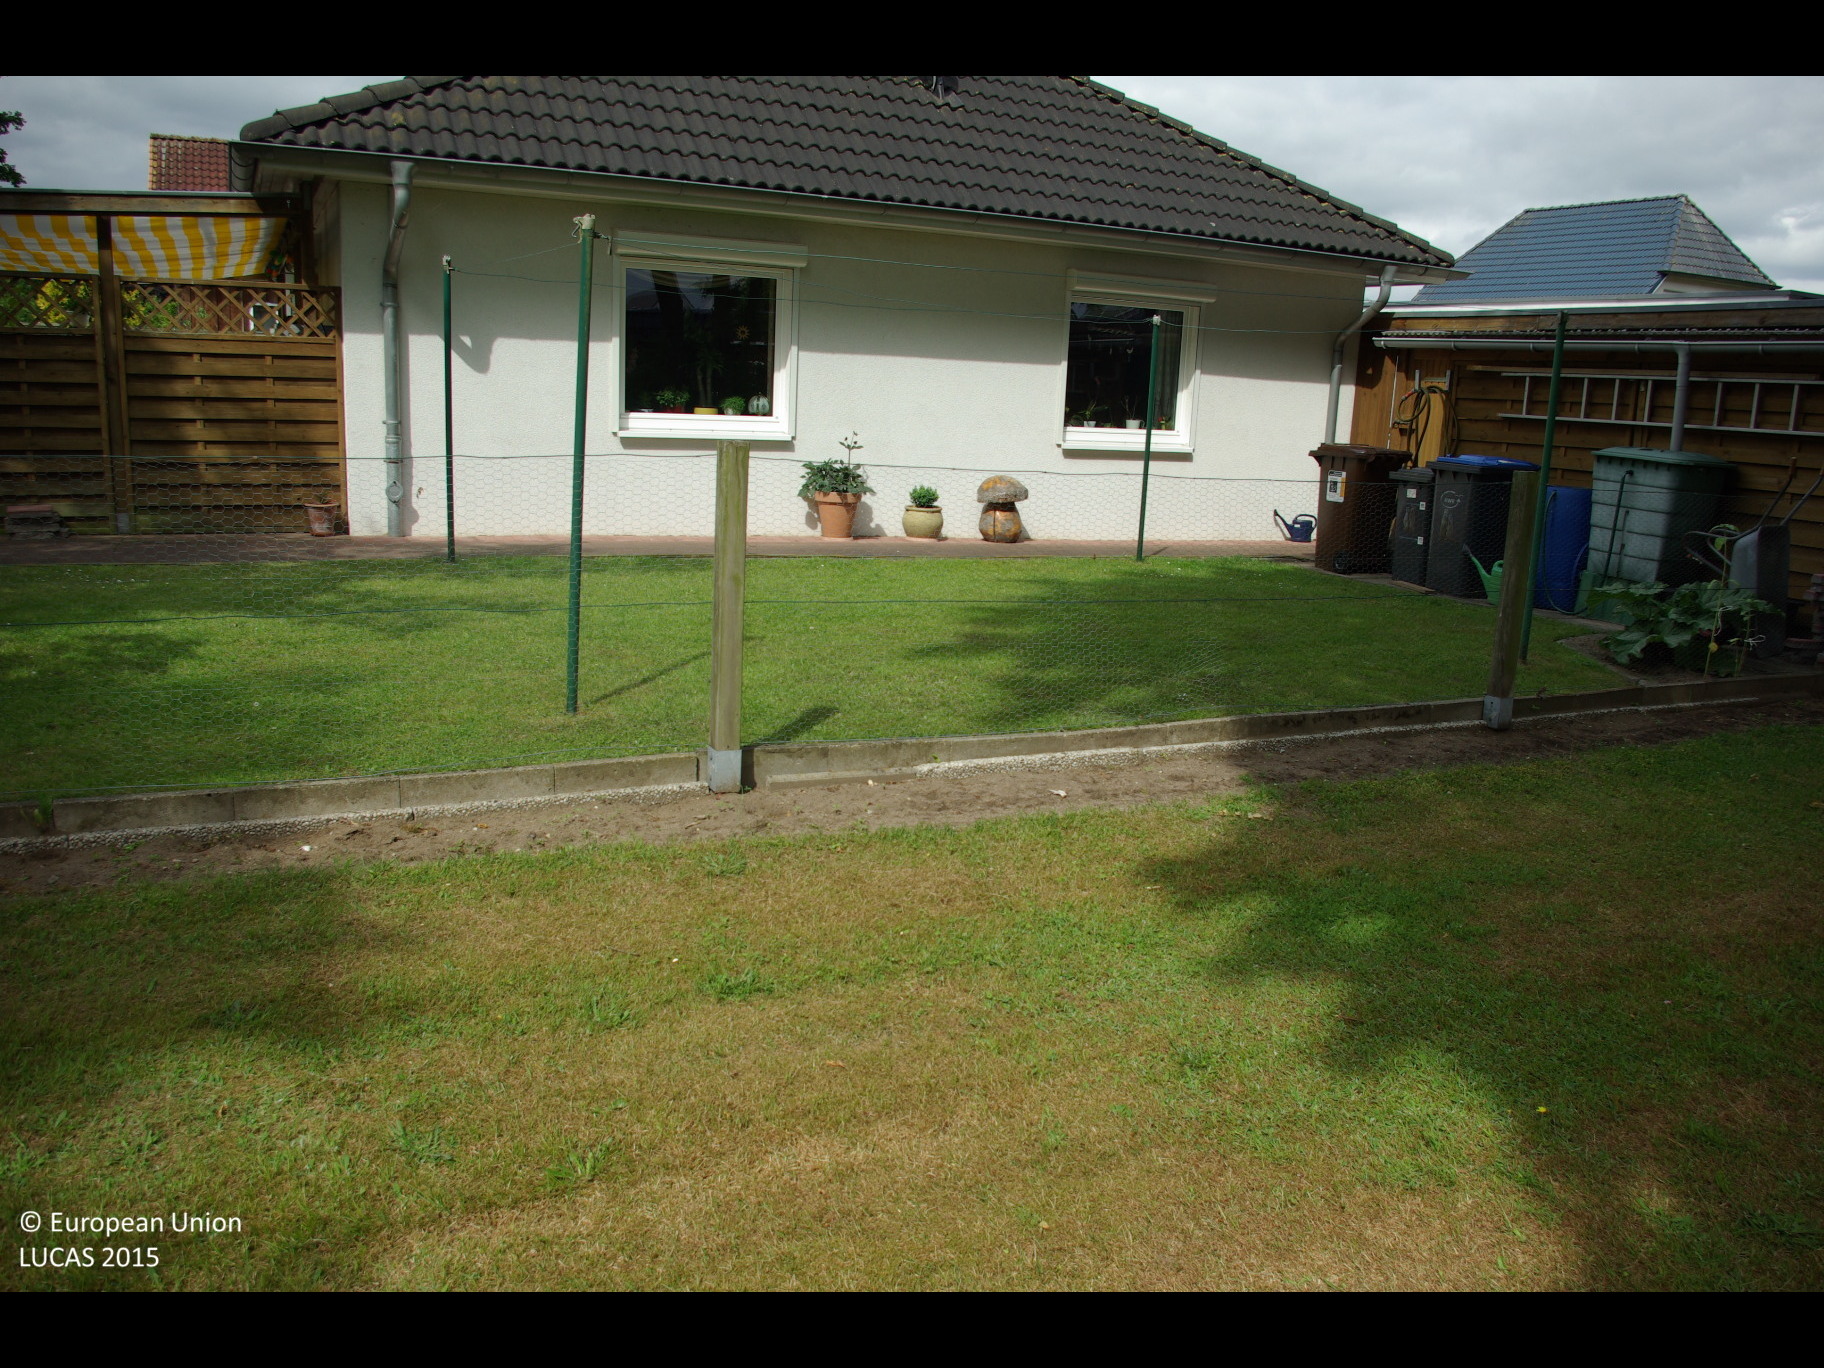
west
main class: Grassland
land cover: Grassland without tree/shrub cover
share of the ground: > 75 %
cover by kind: herbaceous plants 100 %
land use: Residential
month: June
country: DE
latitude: 54.0489
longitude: 9.9542
